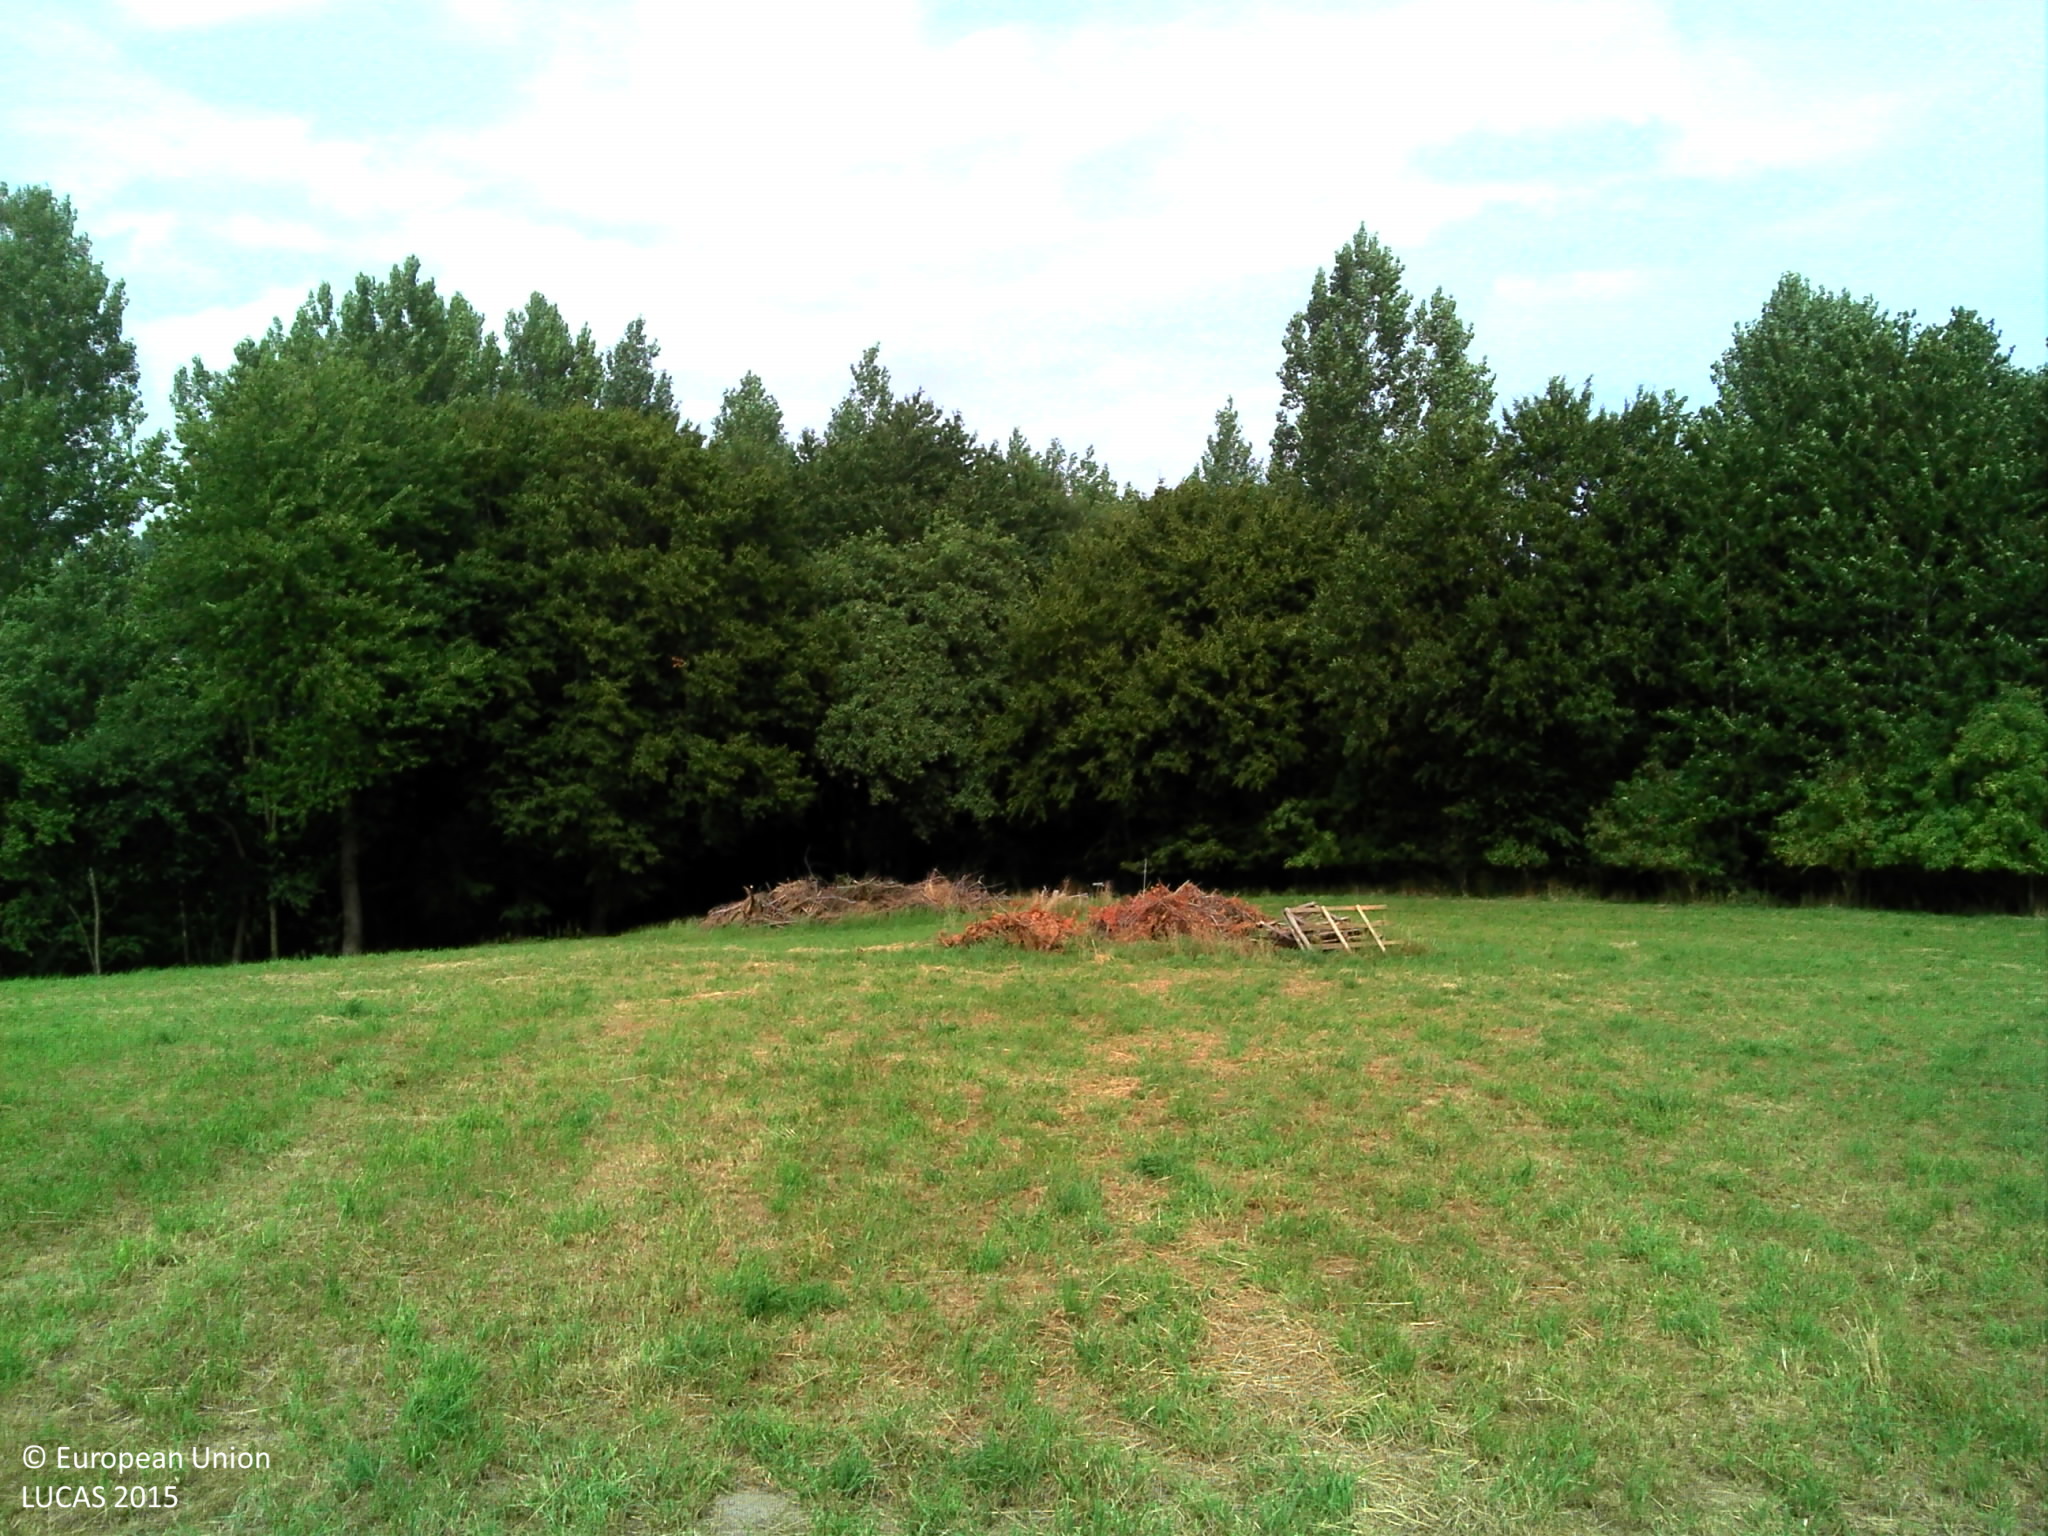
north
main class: Grassland
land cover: Grassland without tree/shrub cover
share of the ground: > 75 %
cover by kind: herbaceous plants 100 %
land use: Agriculture (excluding fallow land and kitchen gardens)
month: August
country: BE
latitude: 50.7487
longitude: 3.6860
